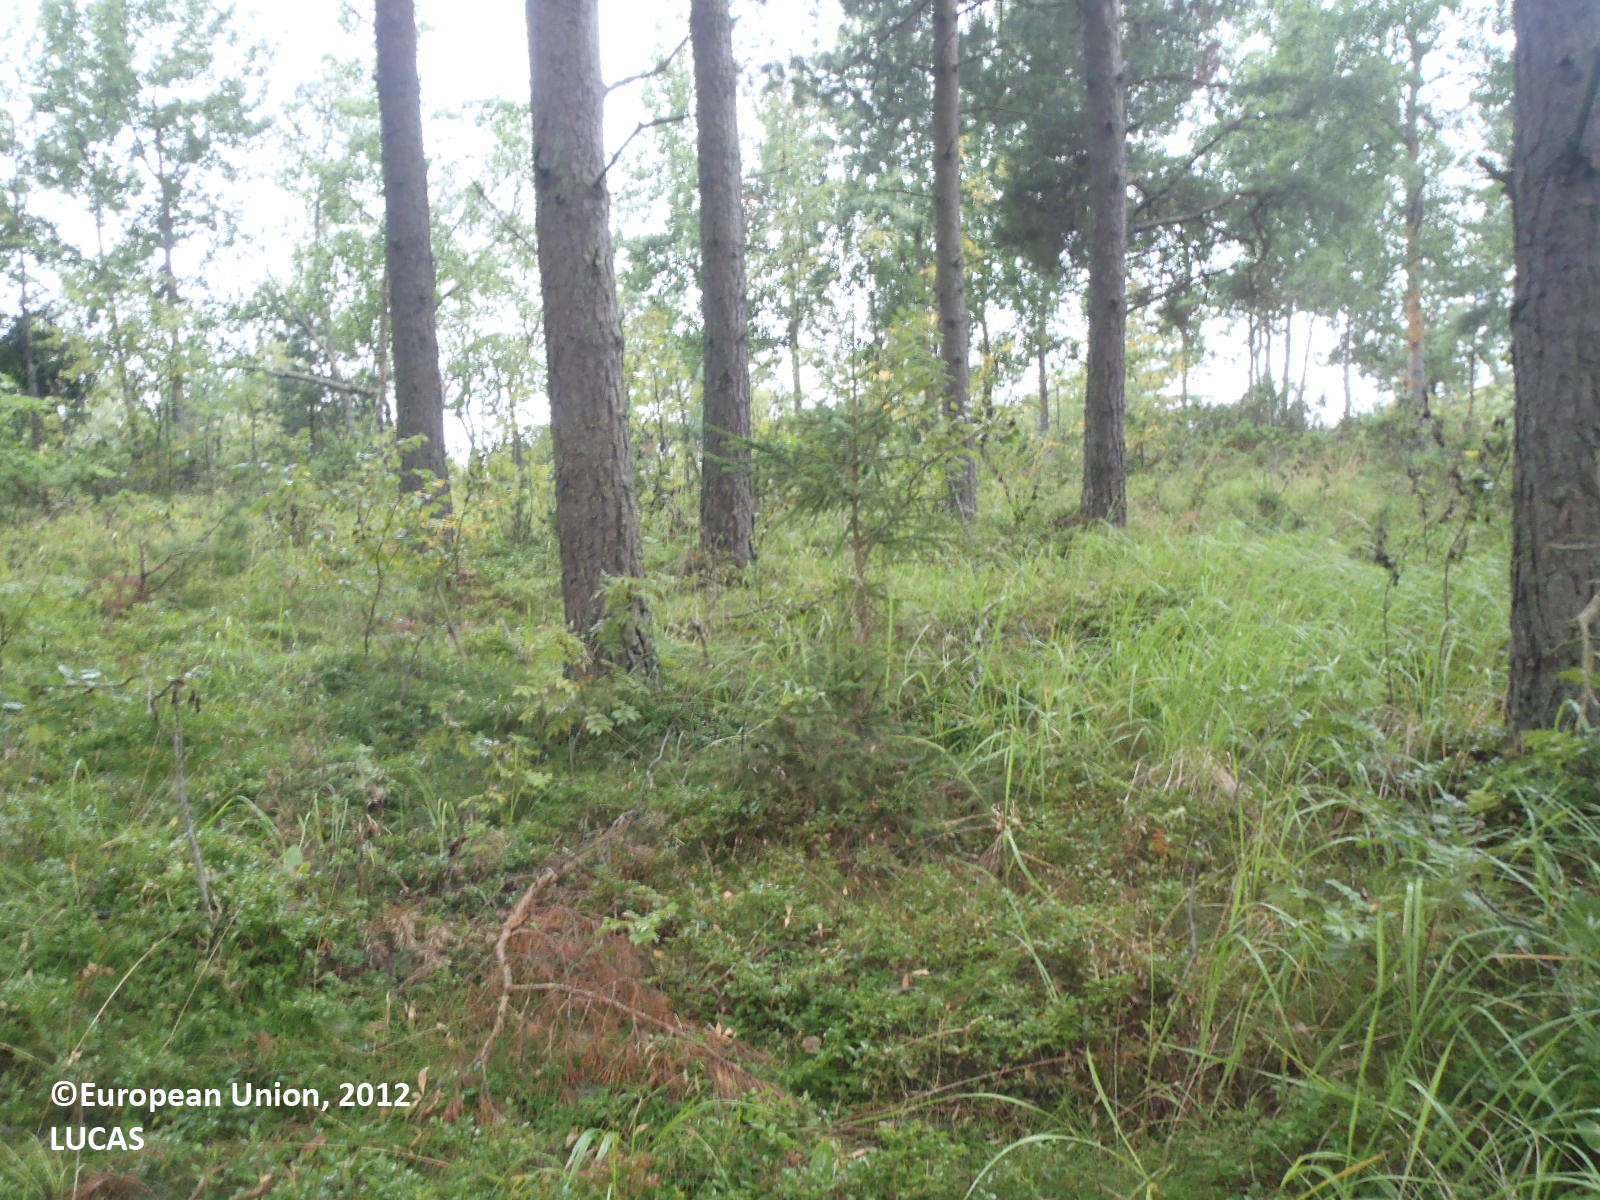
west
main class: Woodland
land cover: Pine dominated coniferous woodland
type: hemiboreal forest and nemoral coniferous forest and mixed broadleaved-coniferous forest
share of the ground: > 75 %
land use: Forestry
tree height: > 5 m
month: August
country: FI
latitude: 60.3187
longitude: 20.9321
